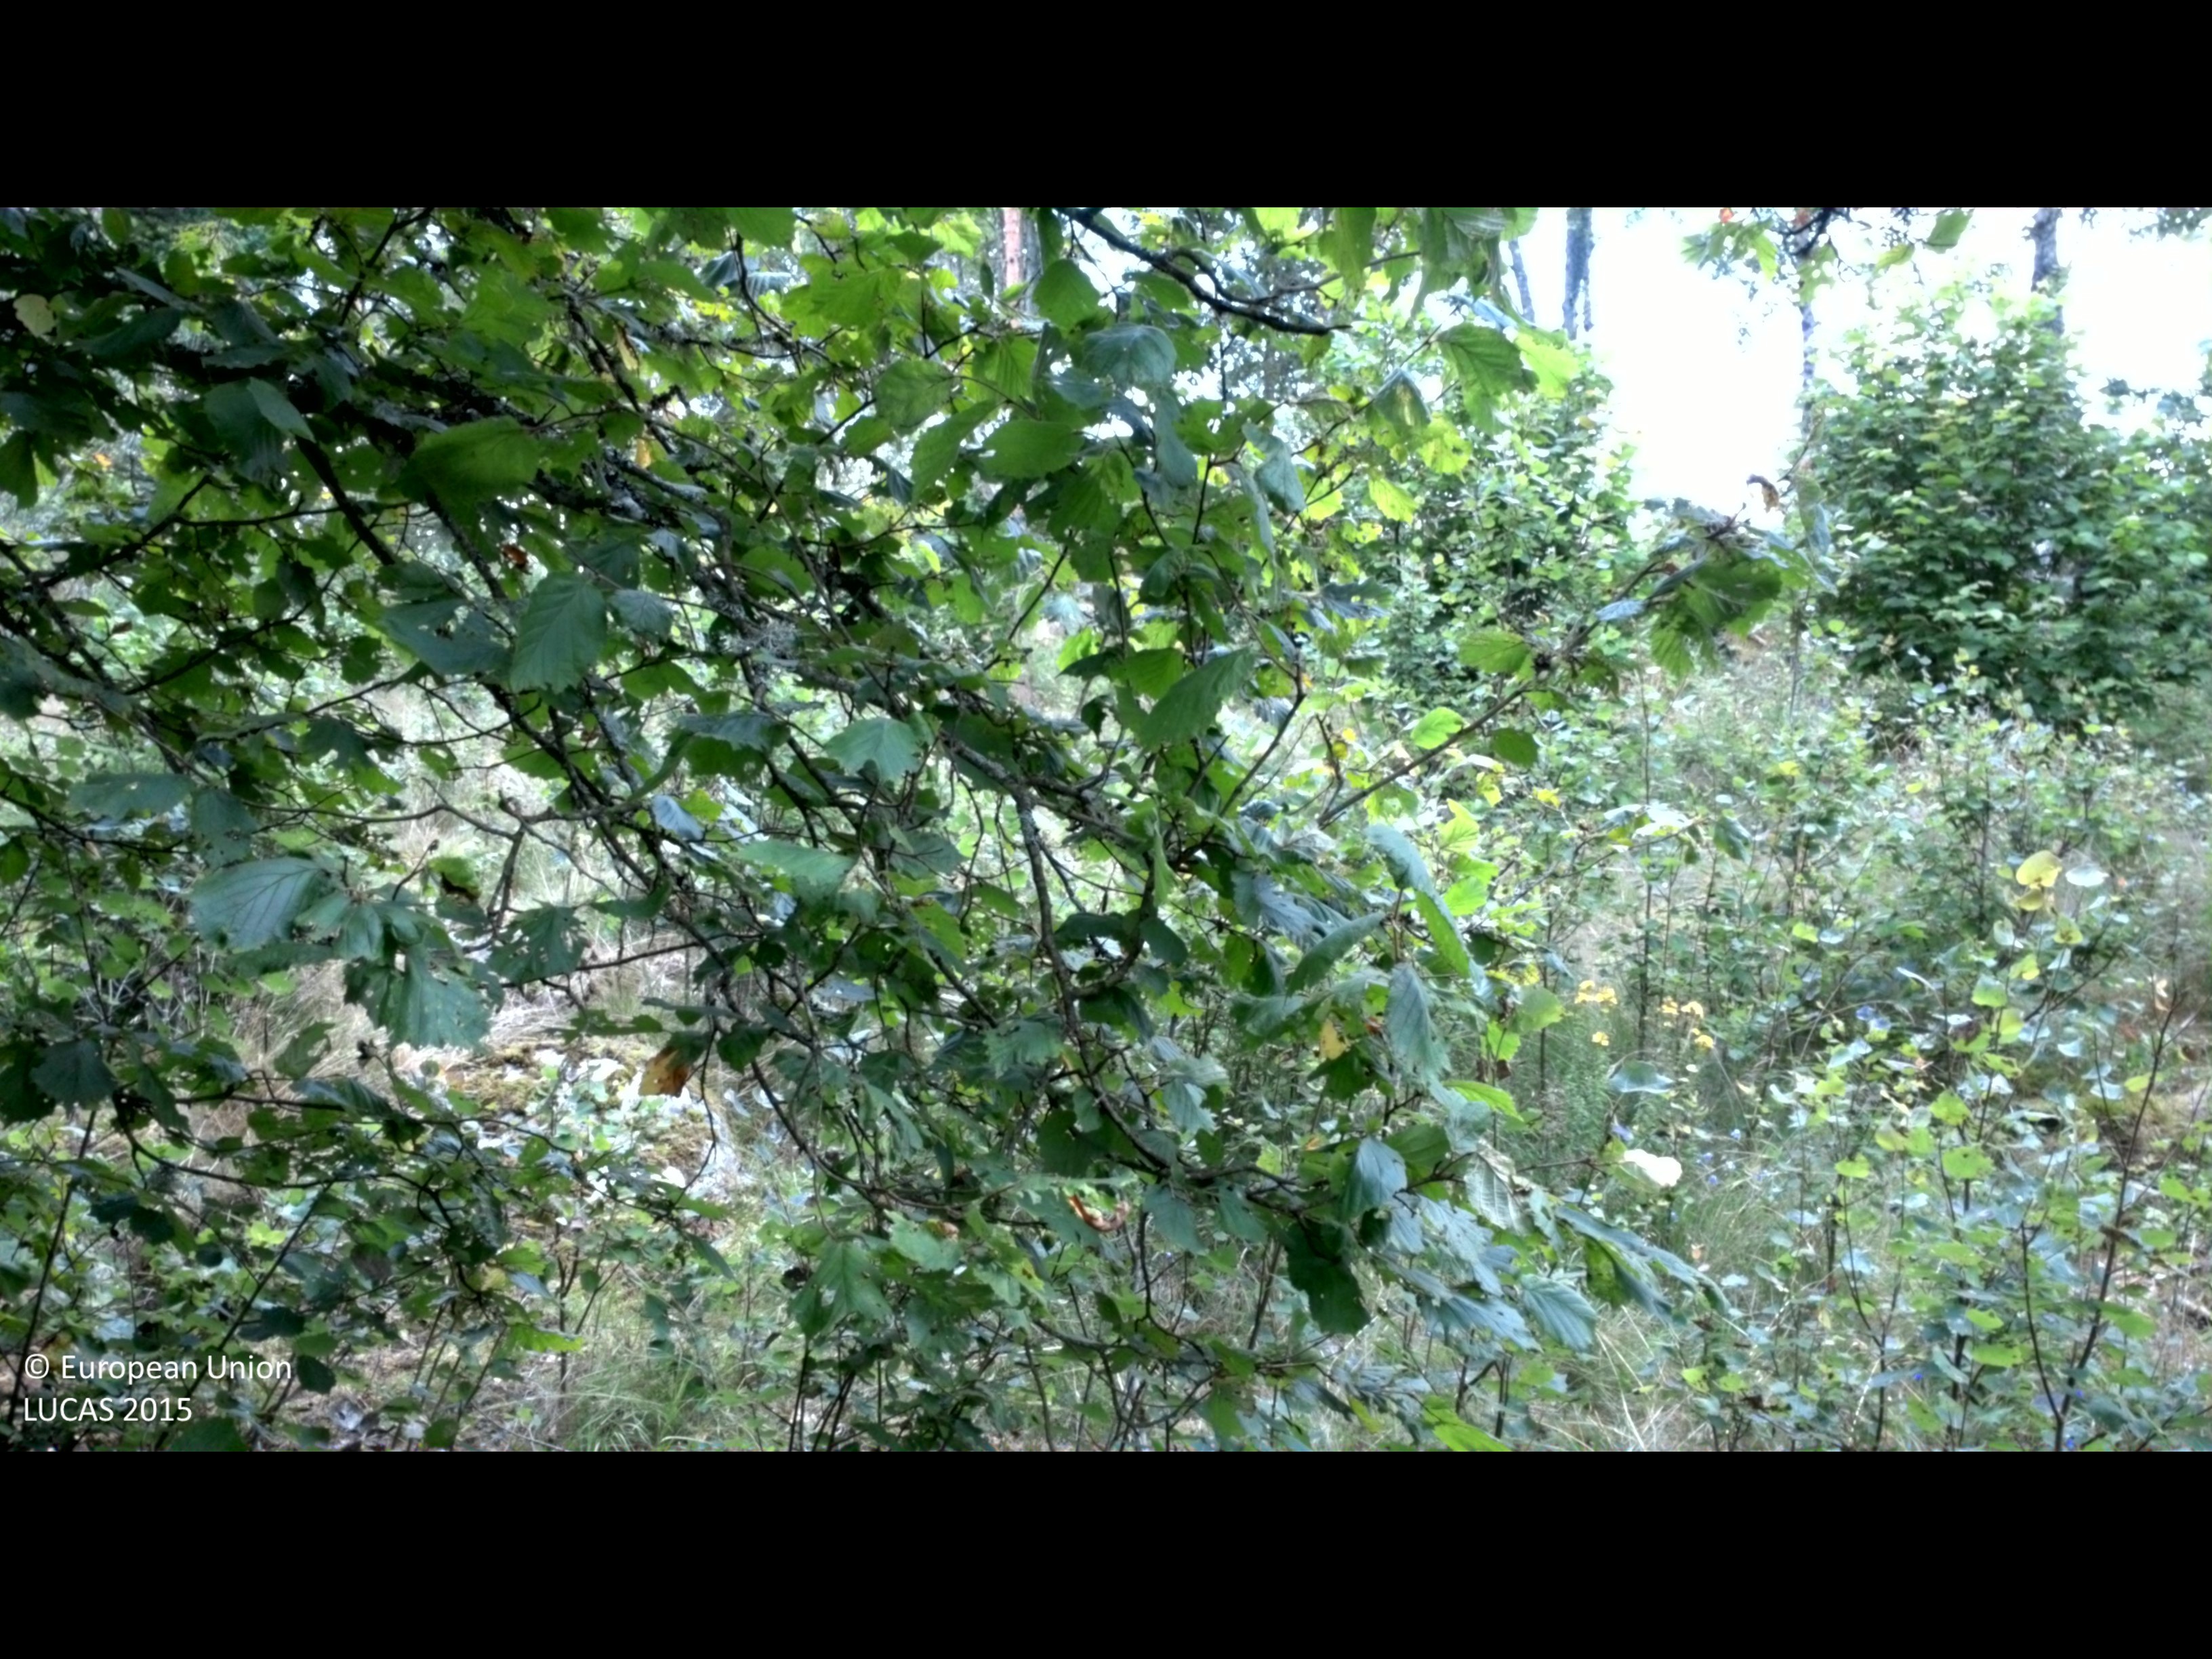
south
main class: Woodland
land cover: Broadleaved woodland
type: hemiboreal forest and nemoral coniferous forest and mixed broadleaved-coniferous forest
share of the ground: 25 - 50 %
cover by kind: broadleaved forest trees 50 %, shrubs 25 %, herbaceous plants 25 %
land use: Forestry
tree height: > 5 m
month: August
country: SE
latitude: 56.7683
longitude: 14.1689
